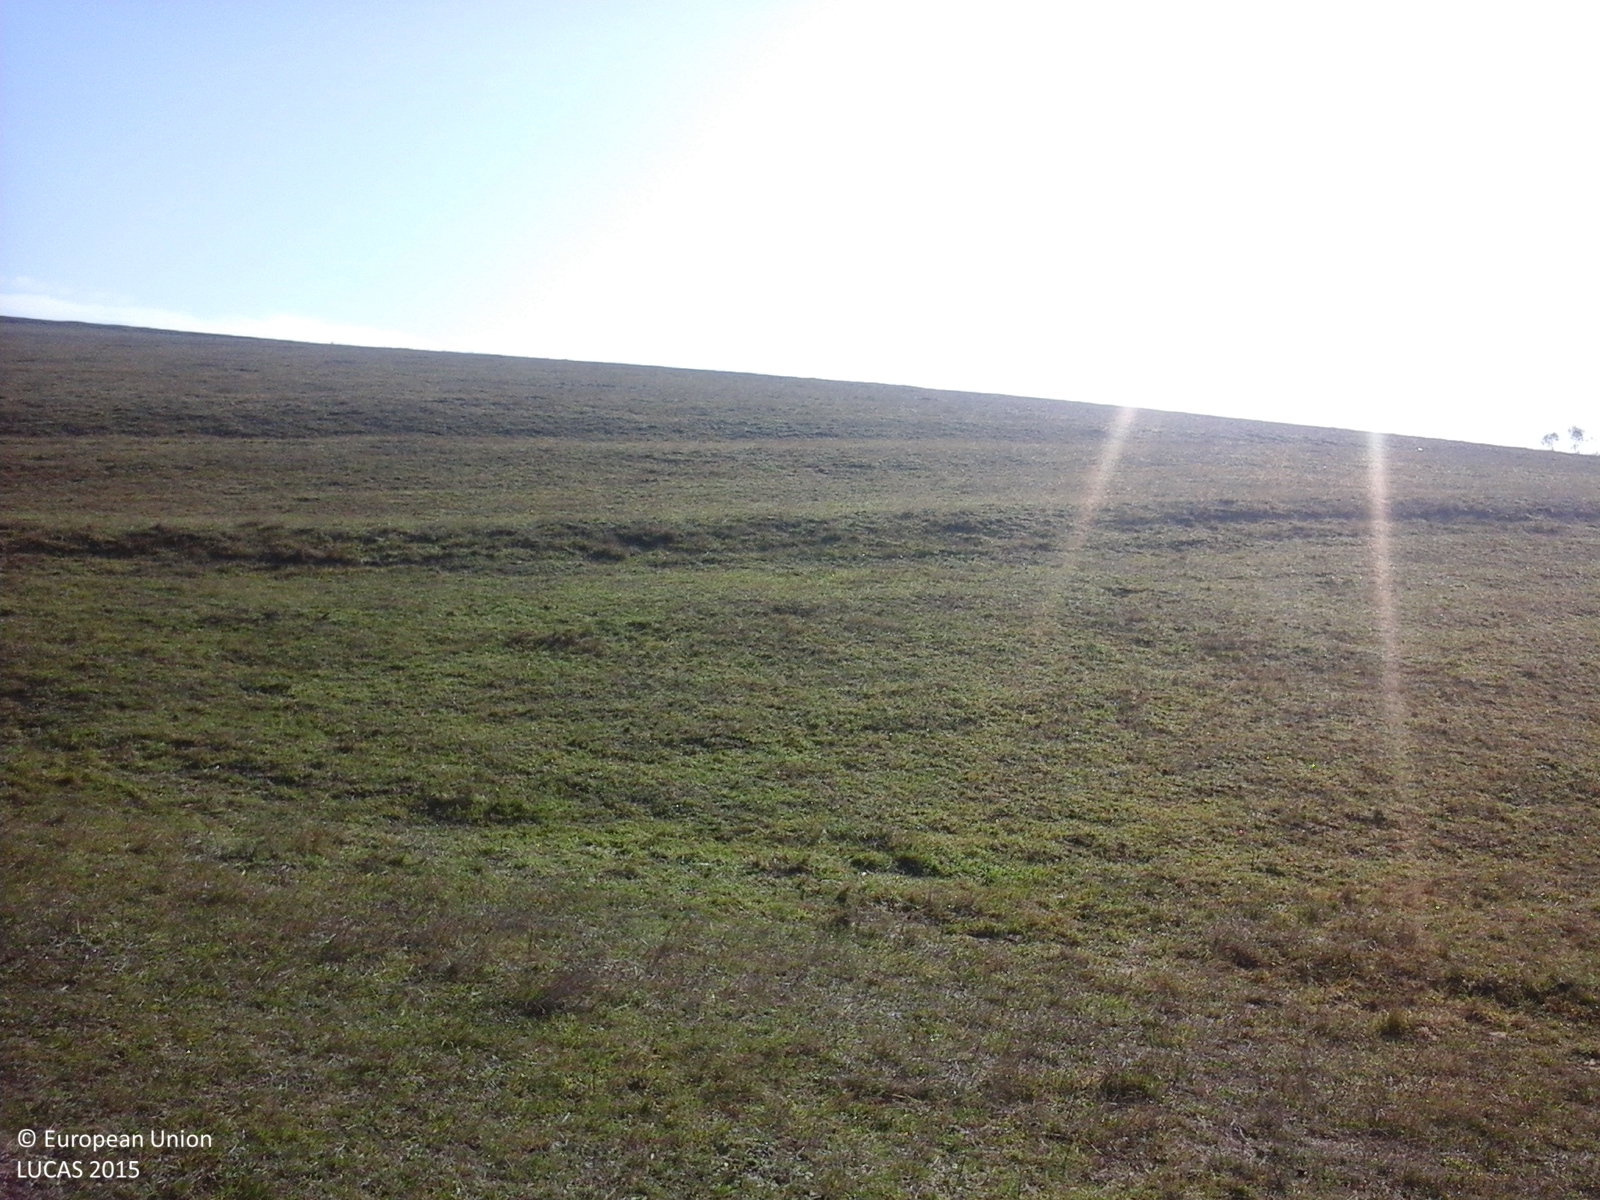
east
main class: Grassland
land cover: Grassland without tree/shrub cover
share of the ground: > 75 %
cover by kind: herbaceous plants 100 %
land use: Agriculture (excluding fallow land and kitchen gardens)
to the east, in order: Grassland without tree/shrub cover; Ditches and canals; Grassland without tree/shrub cover
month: October
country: RO
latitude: 46.0637
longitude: 26.0584
